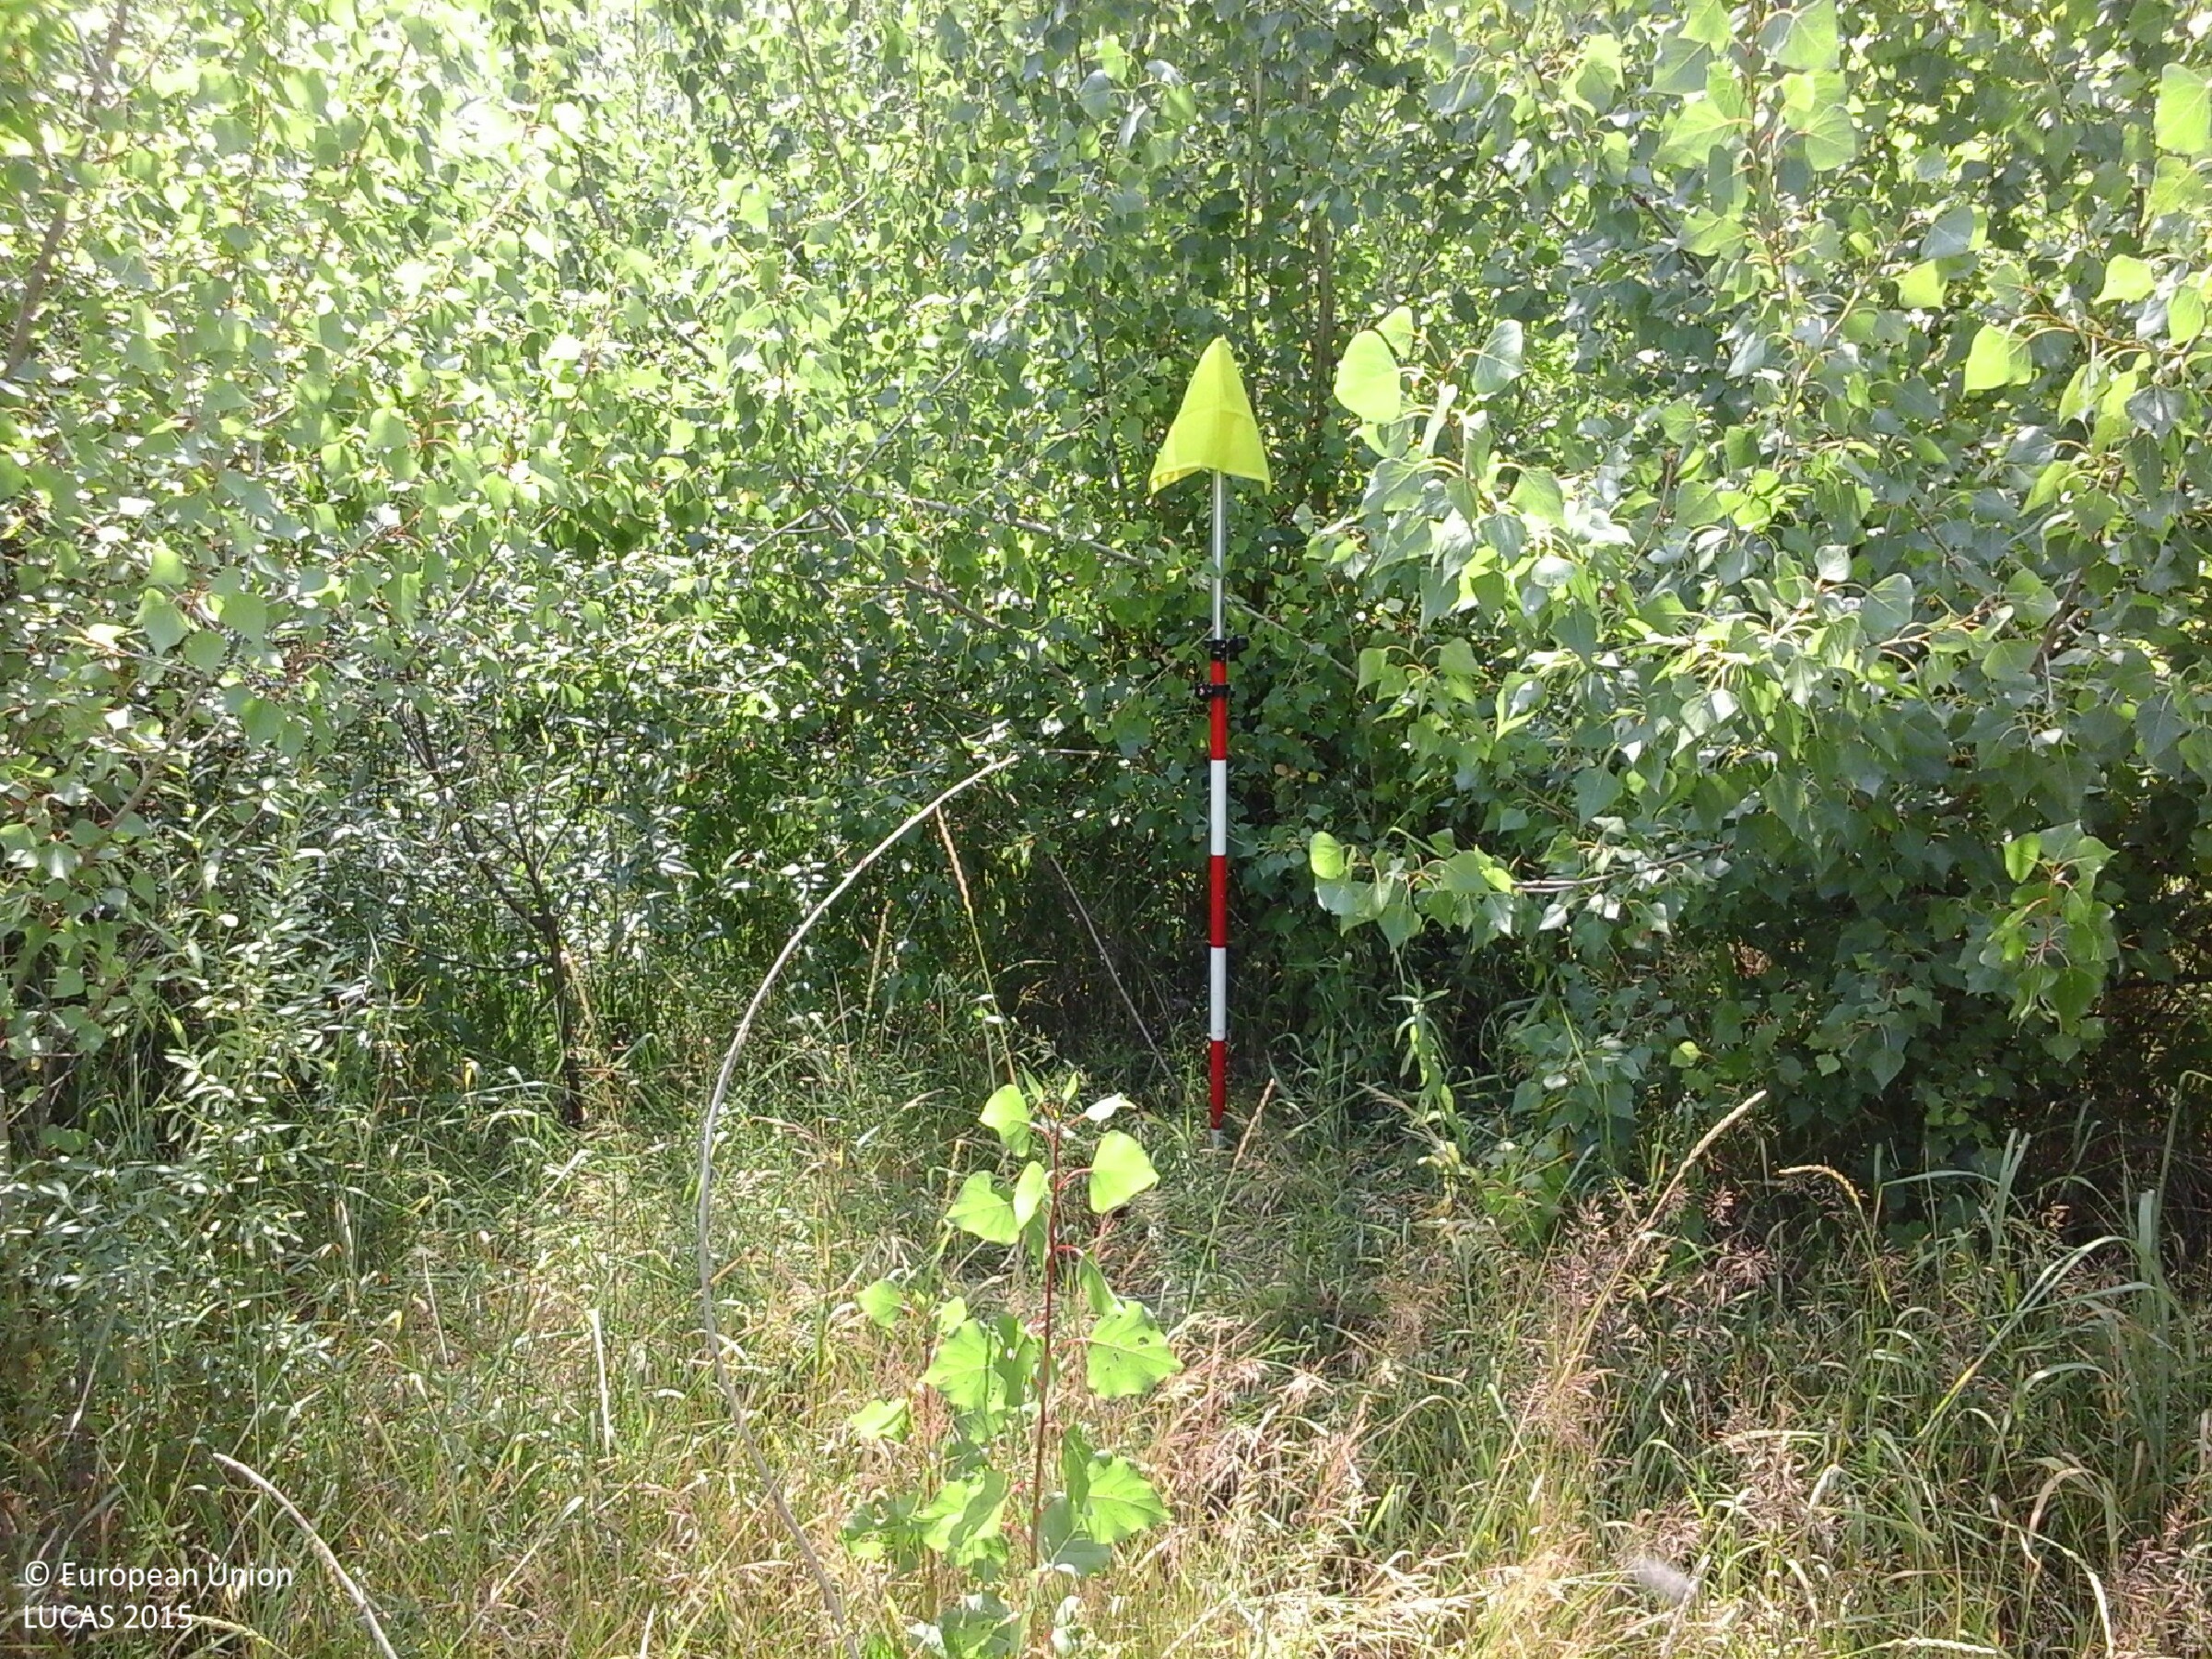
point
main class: Woodland
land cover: Broadleaved woodland
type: floodplain forest
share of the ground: 50 - 75 %
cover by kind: broadleaved forest trees 60 %, herbaceous plants 40 %
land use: Semi-natural and natural areas not in use
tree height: < 5 m
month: July
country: HU
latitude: 48.0455
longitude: 20.8899
